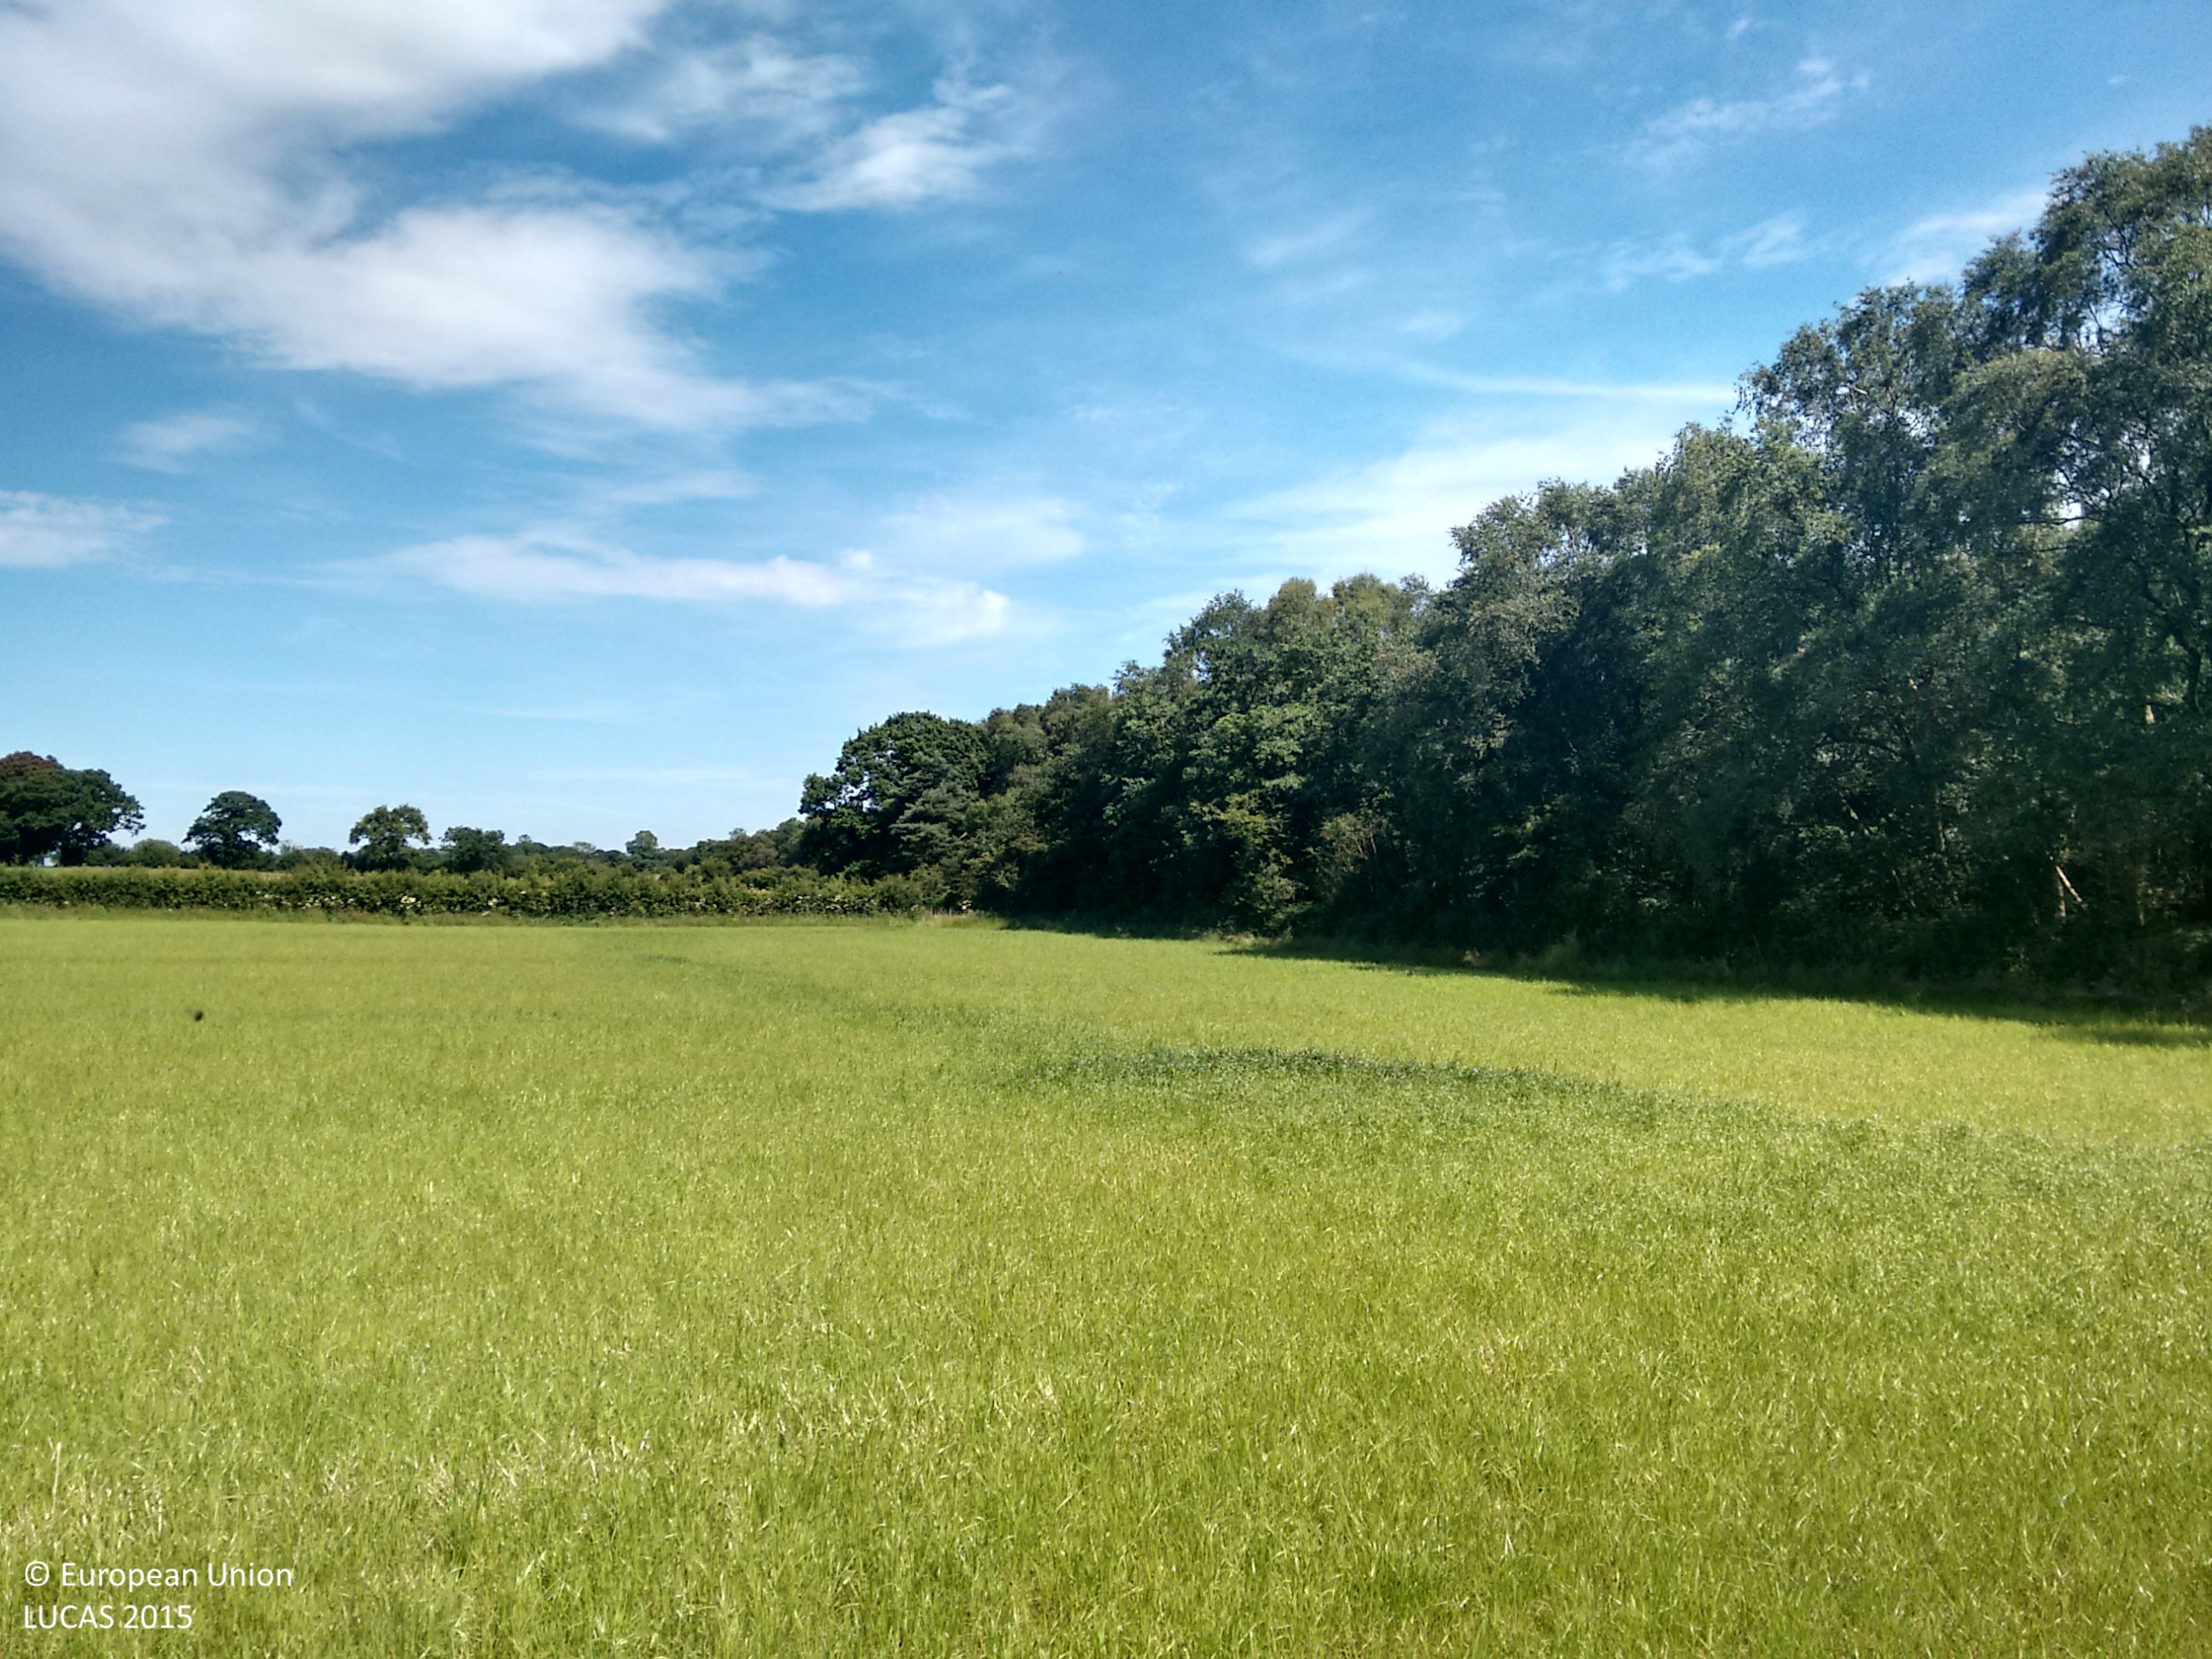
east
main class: Cropland
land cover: Temporary grasslands
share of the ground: > 75 %
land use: Agriculture (excluding fallow land and kitchen gardens)
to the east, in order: Temporary grasslands; Fences; Managed hedges; Temporary grasslands; Fences; Broadleaved woodland
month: July
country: GB
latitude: 53.3321
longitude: -2.5143
